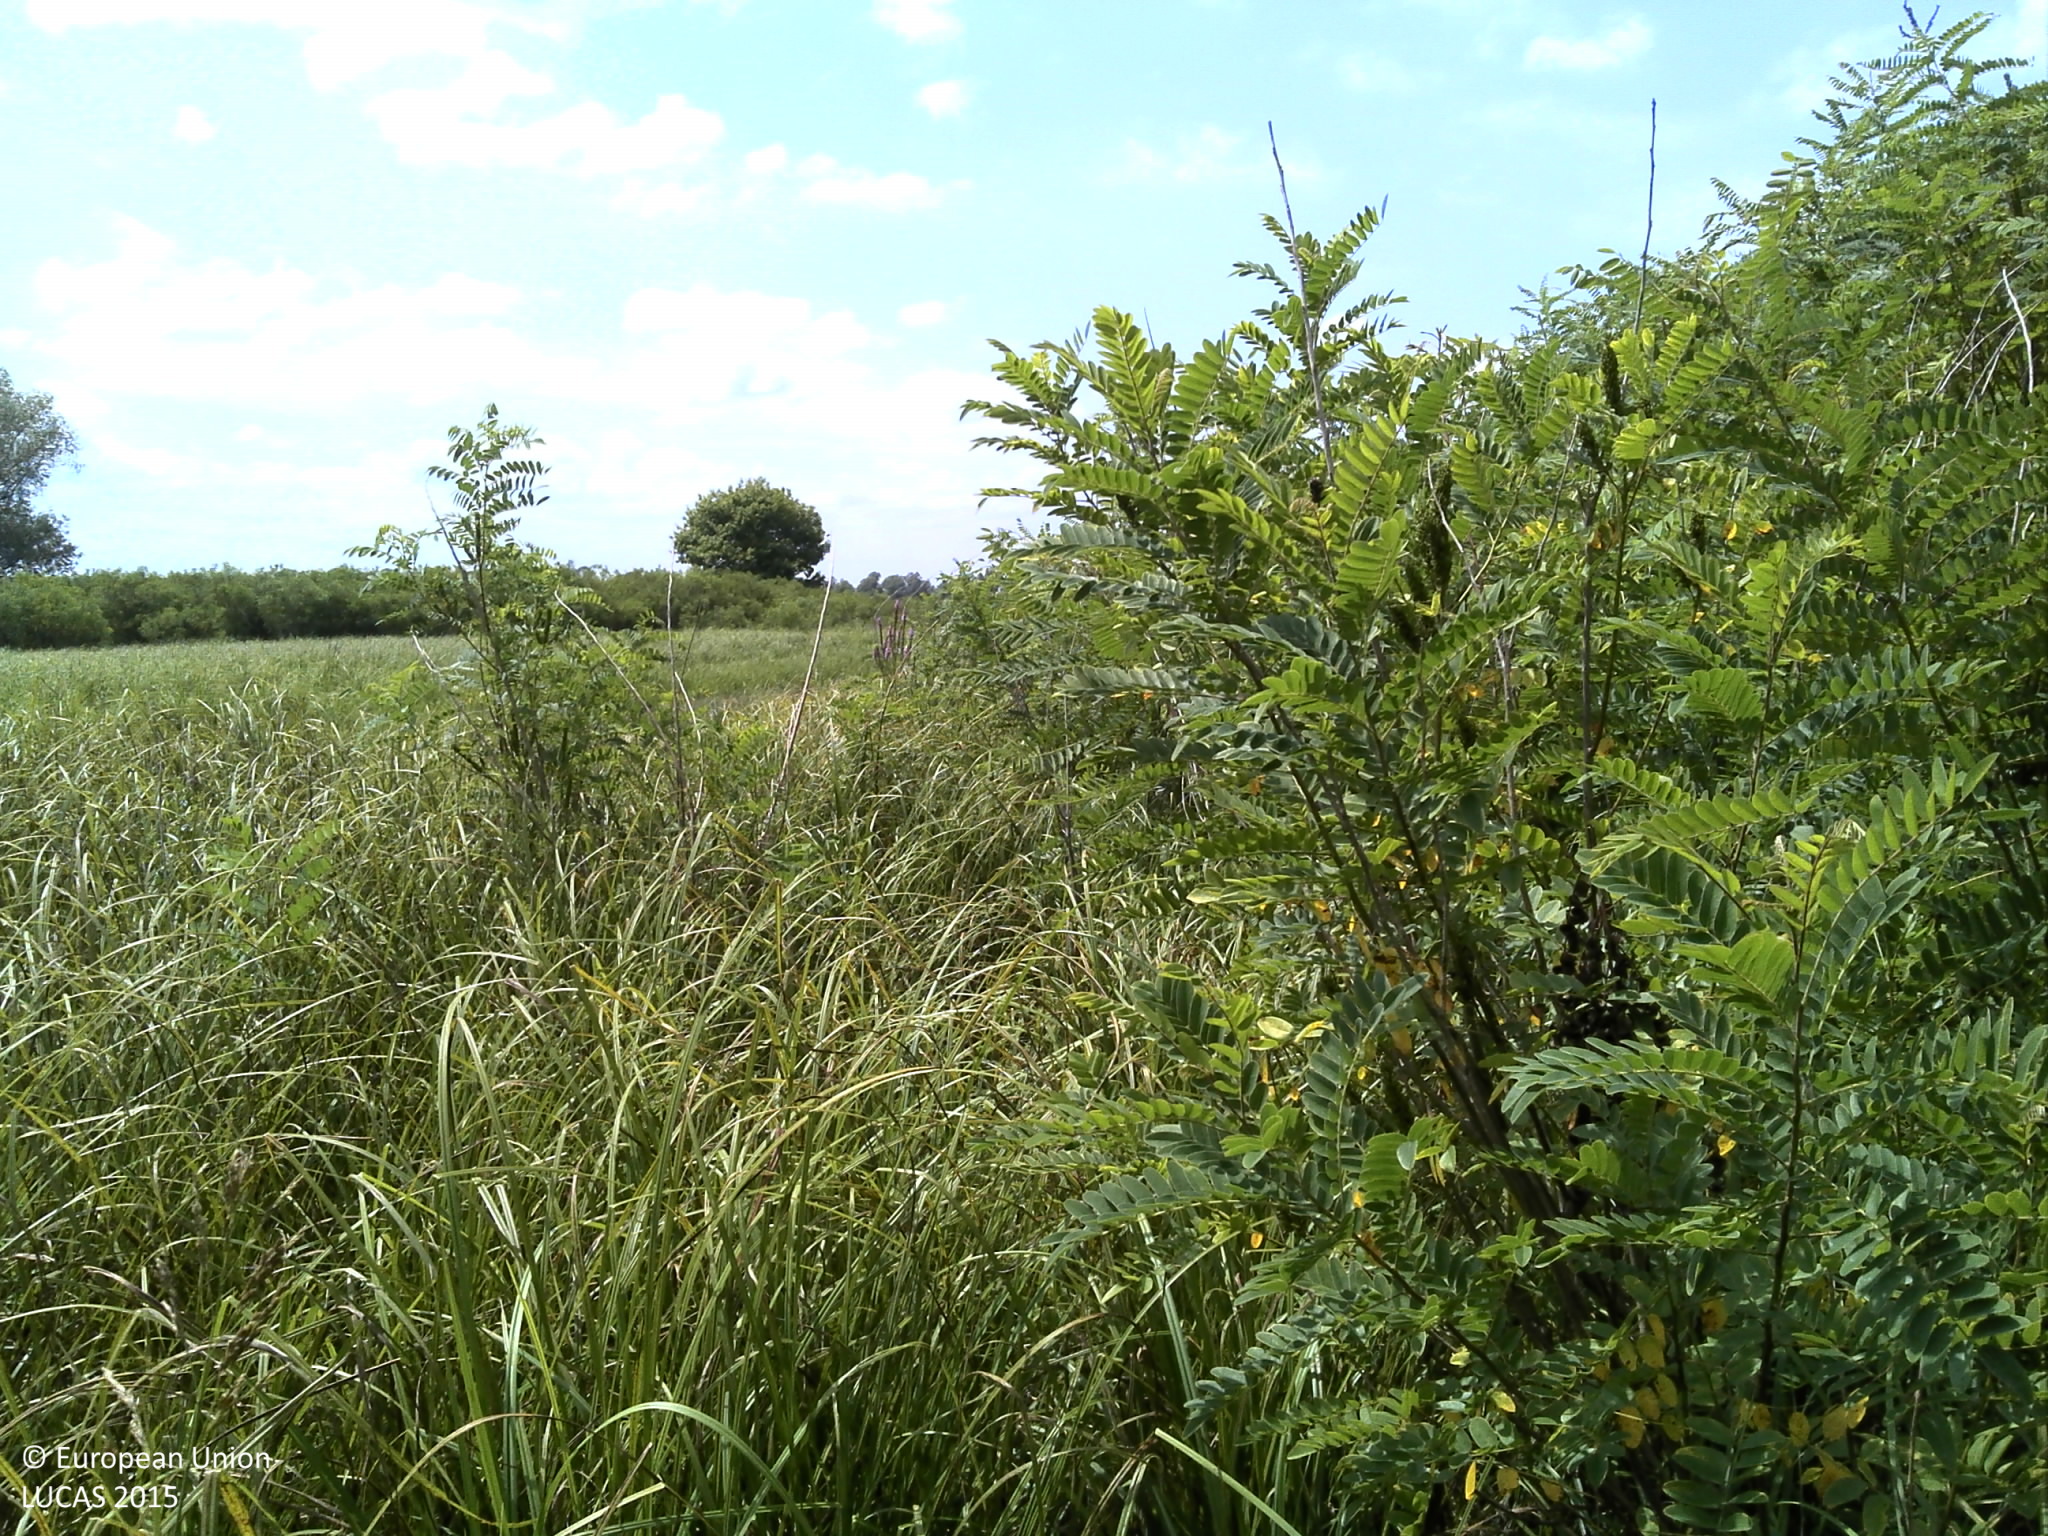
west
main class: Grassland
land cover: Grassland without tree/shrub cover
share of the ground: > 75 %
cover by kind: herbaceous plants 100 %
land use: Semi-natural and natural areas not in use
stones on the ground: < 10 %
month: August
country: HR
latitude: 45.4942
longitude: 16.6398
